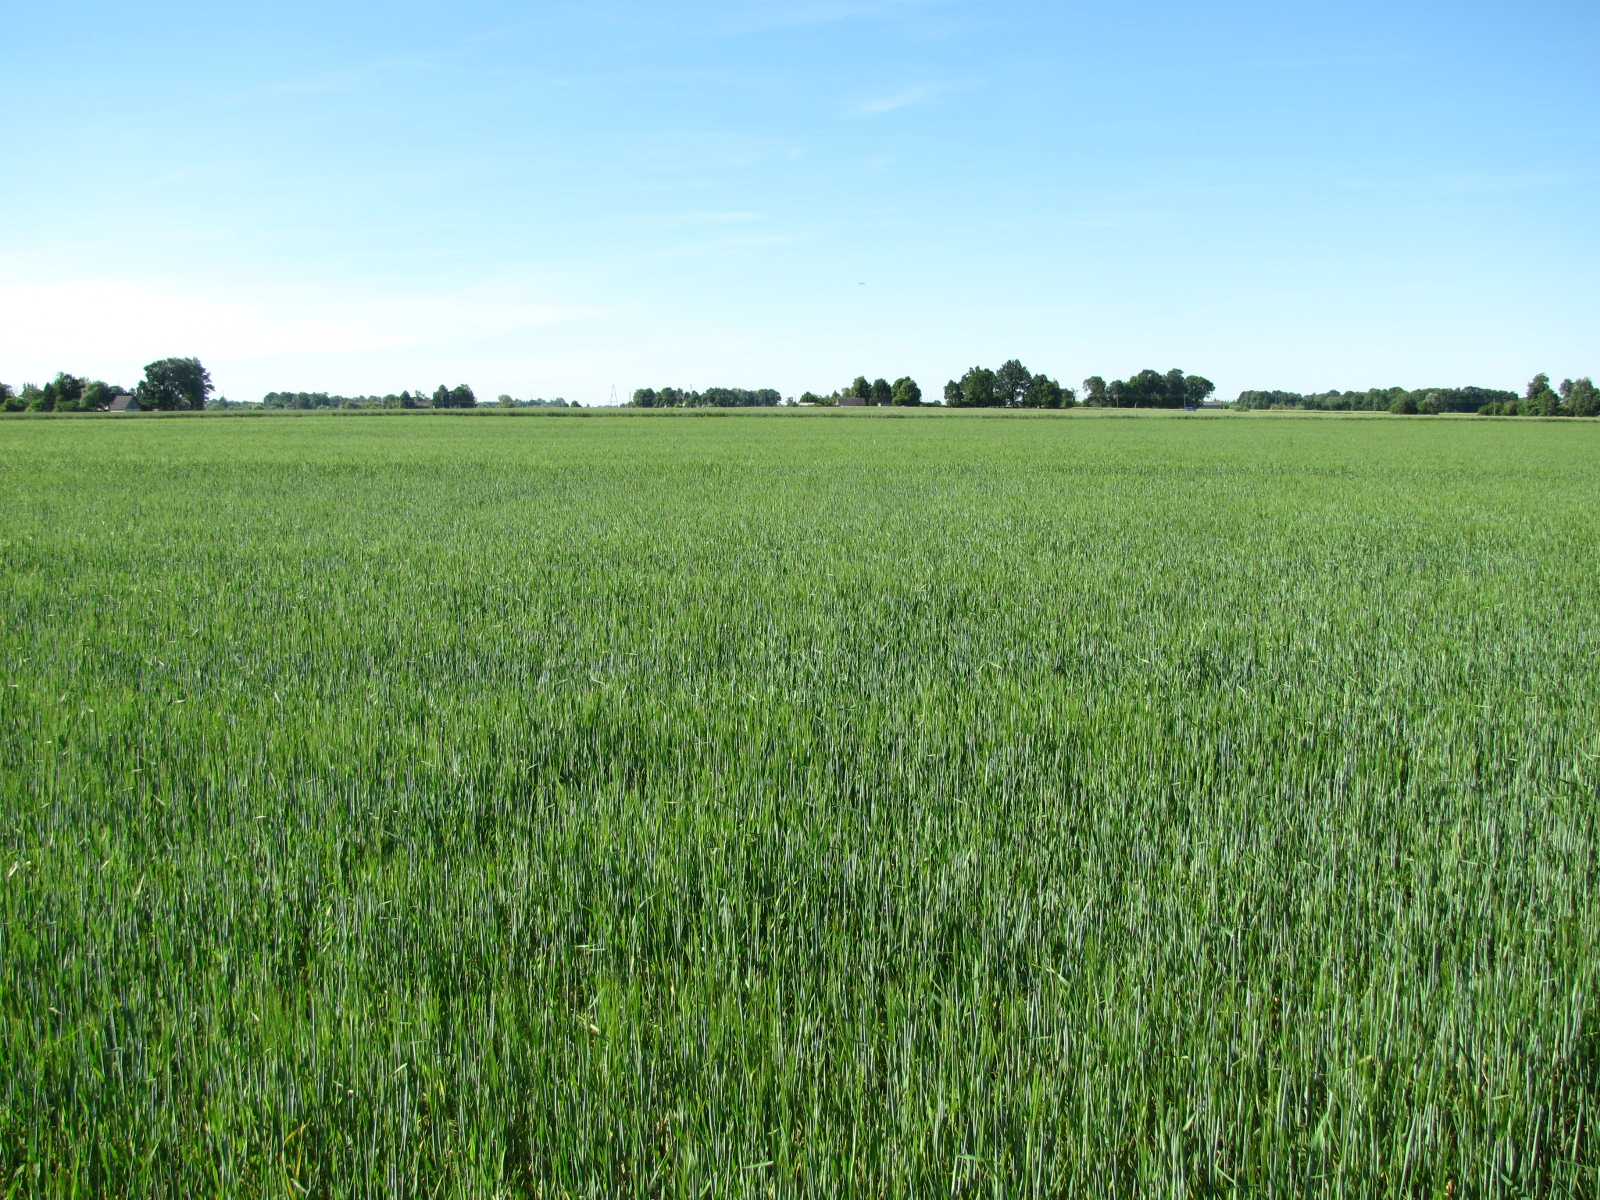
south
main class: Cropland
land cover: Barley
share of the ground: > 75 %
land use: Agriculture (excluding fallow land and kitchen gardens)
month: July
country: LV
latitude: 56.5105
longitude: 23.8455
